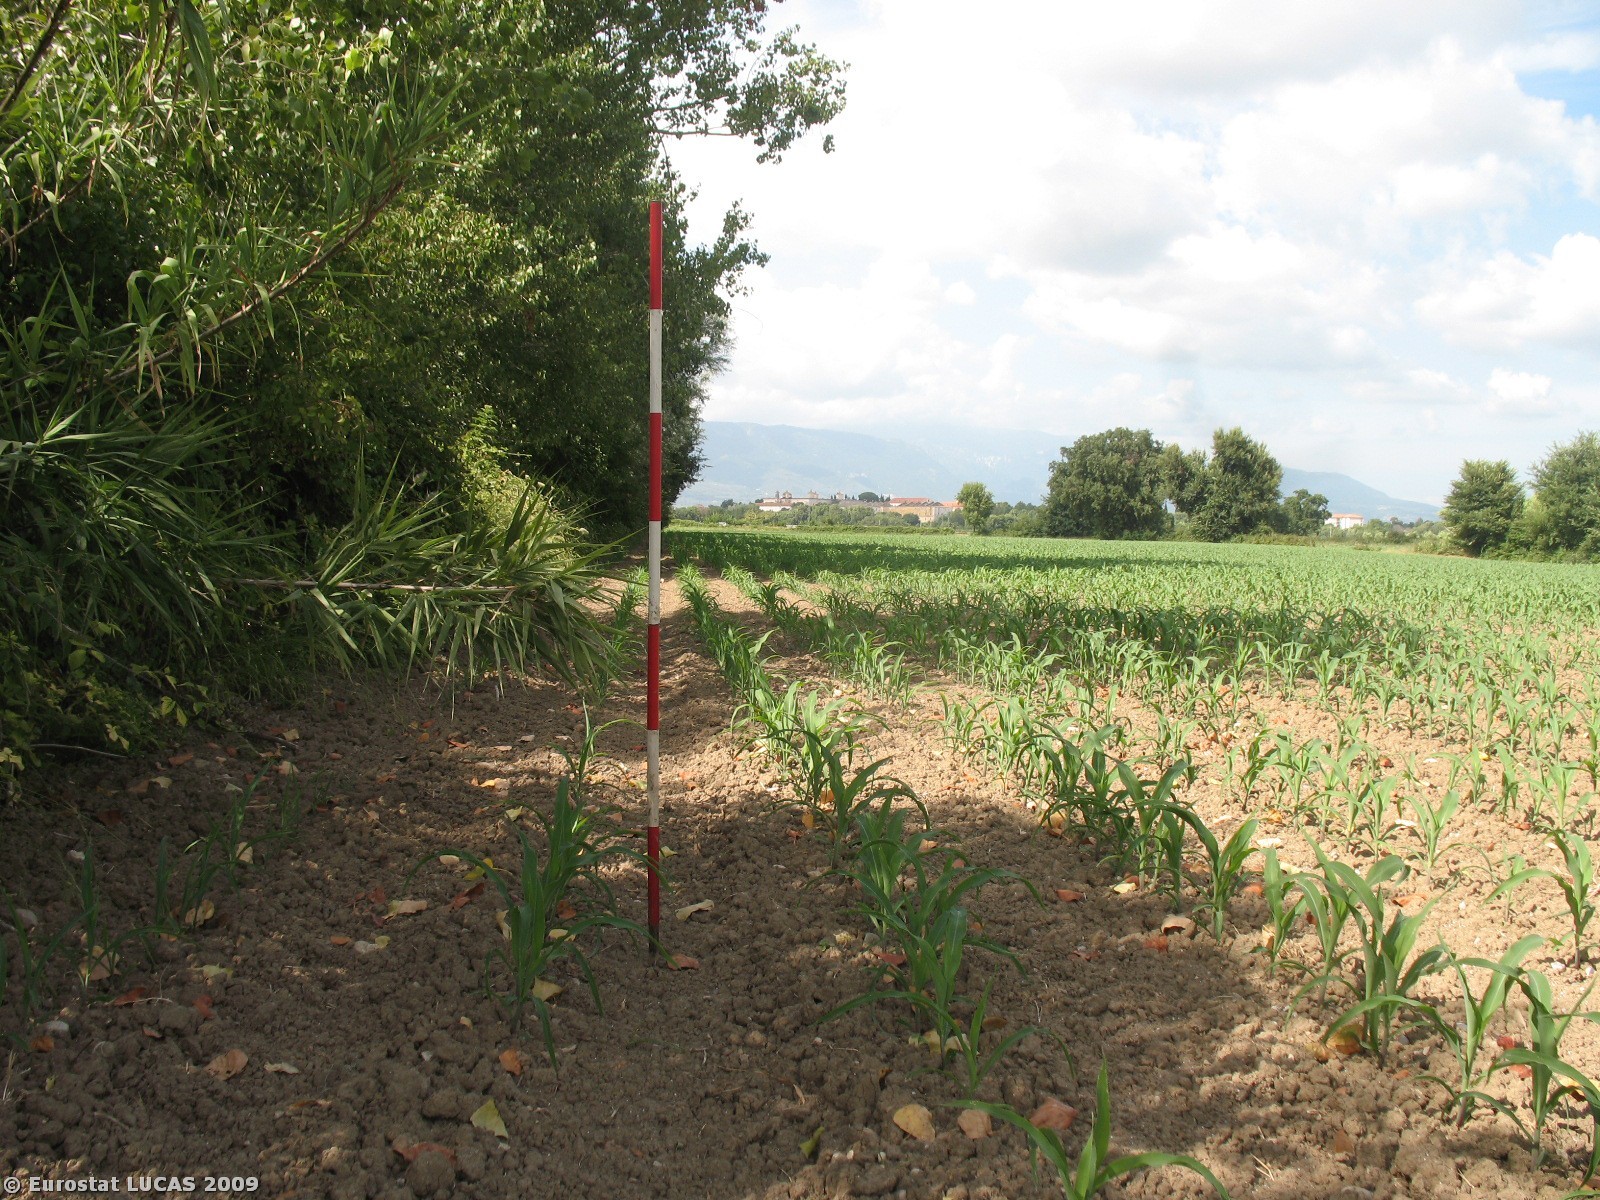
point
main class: Cropland
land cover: Maize
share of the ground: 25 - 50 %
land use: Agriculture (excluding fallow land and kitchen gardens)
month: July
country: IT
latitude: 40.5364
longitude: 15.0436
